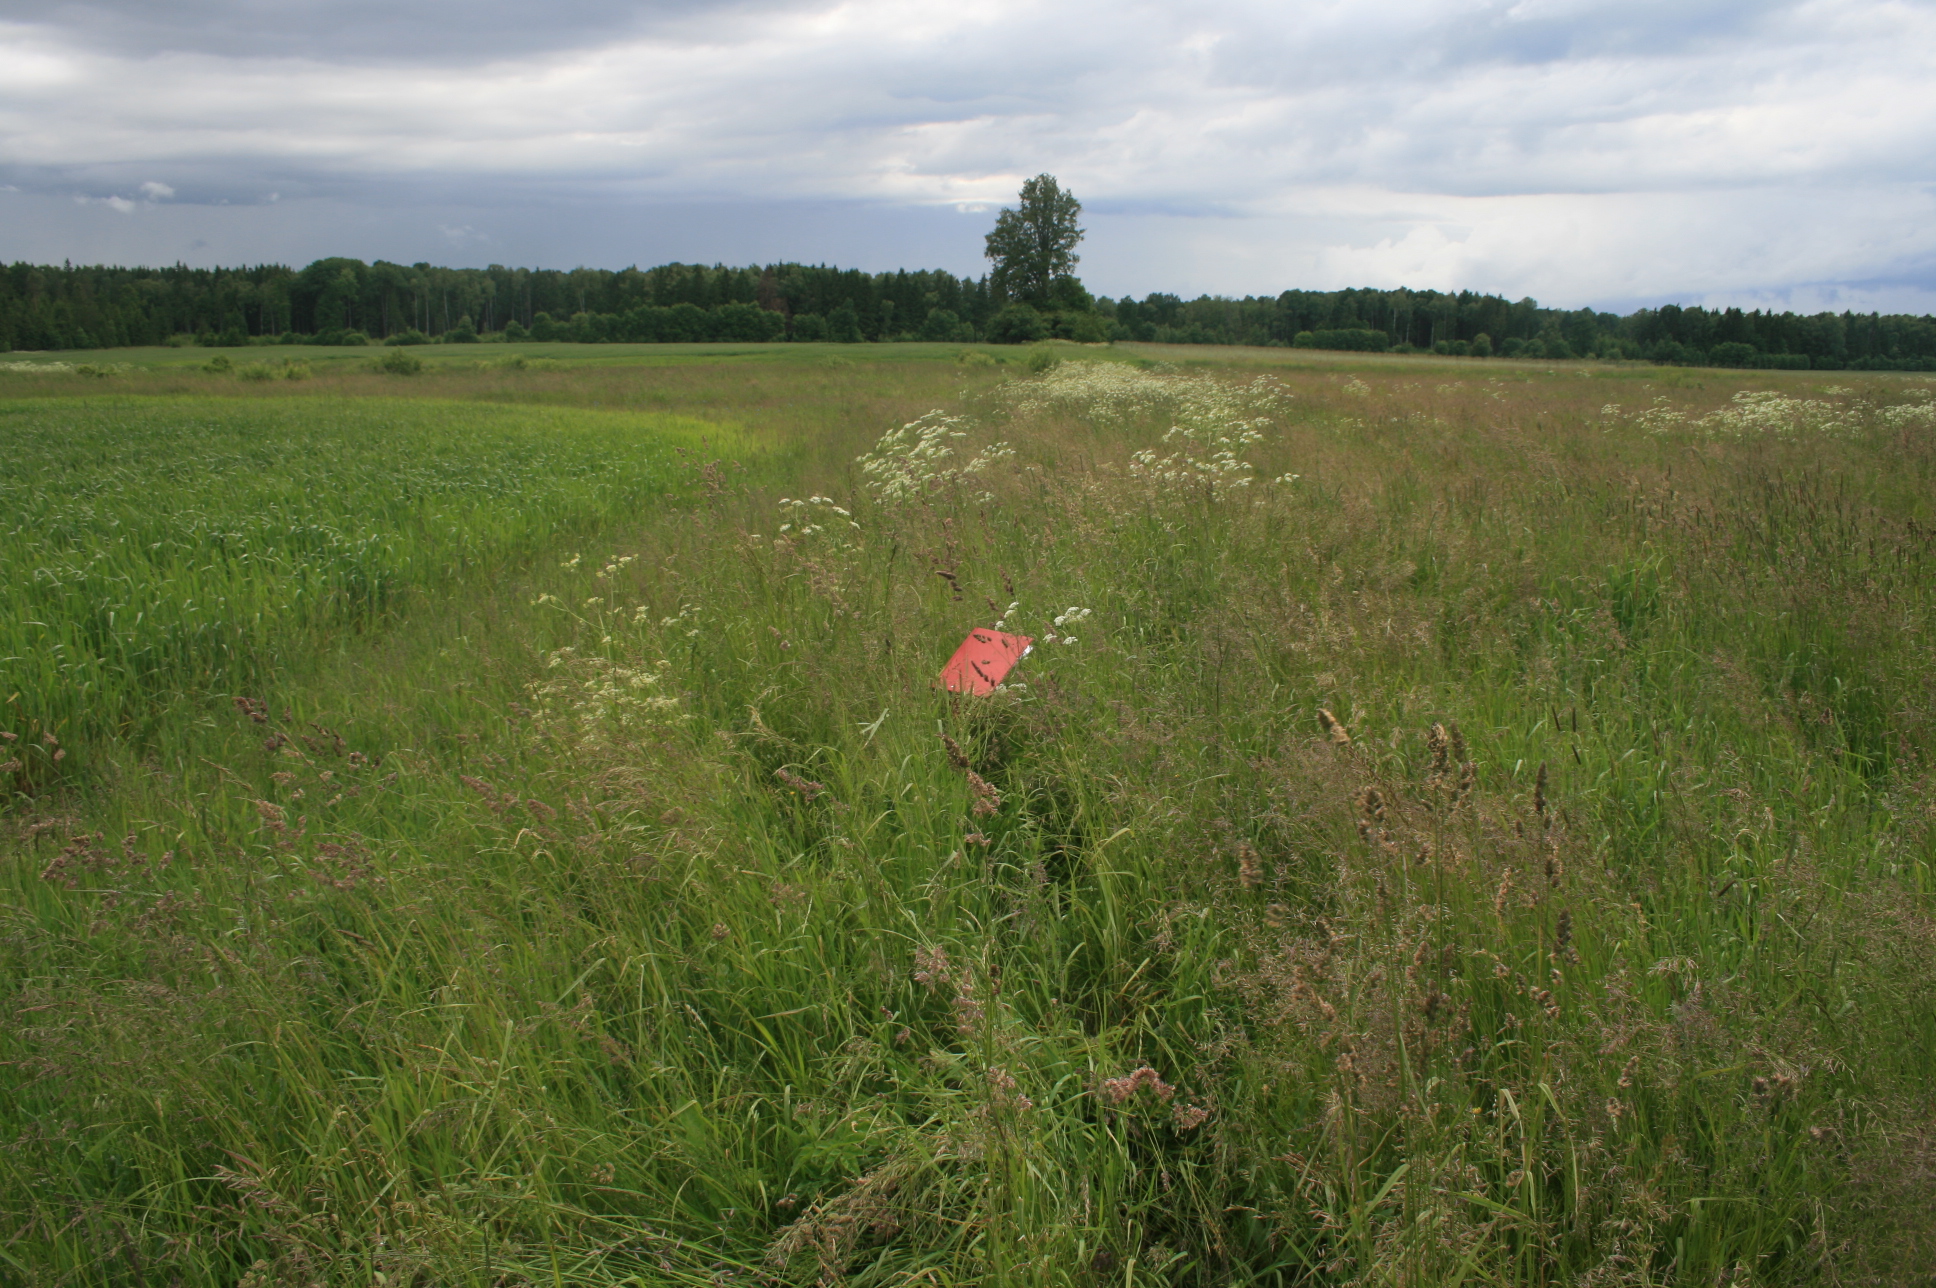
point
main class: Grassland
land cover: Grassland without tree/shrub cover
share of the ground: > 75 %
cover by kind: herbaceous plants 100 %
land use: Agriculture (excluding fallow land and kitchen gardens)
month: June
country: LT
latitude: 55.4258
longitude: 22.3359
